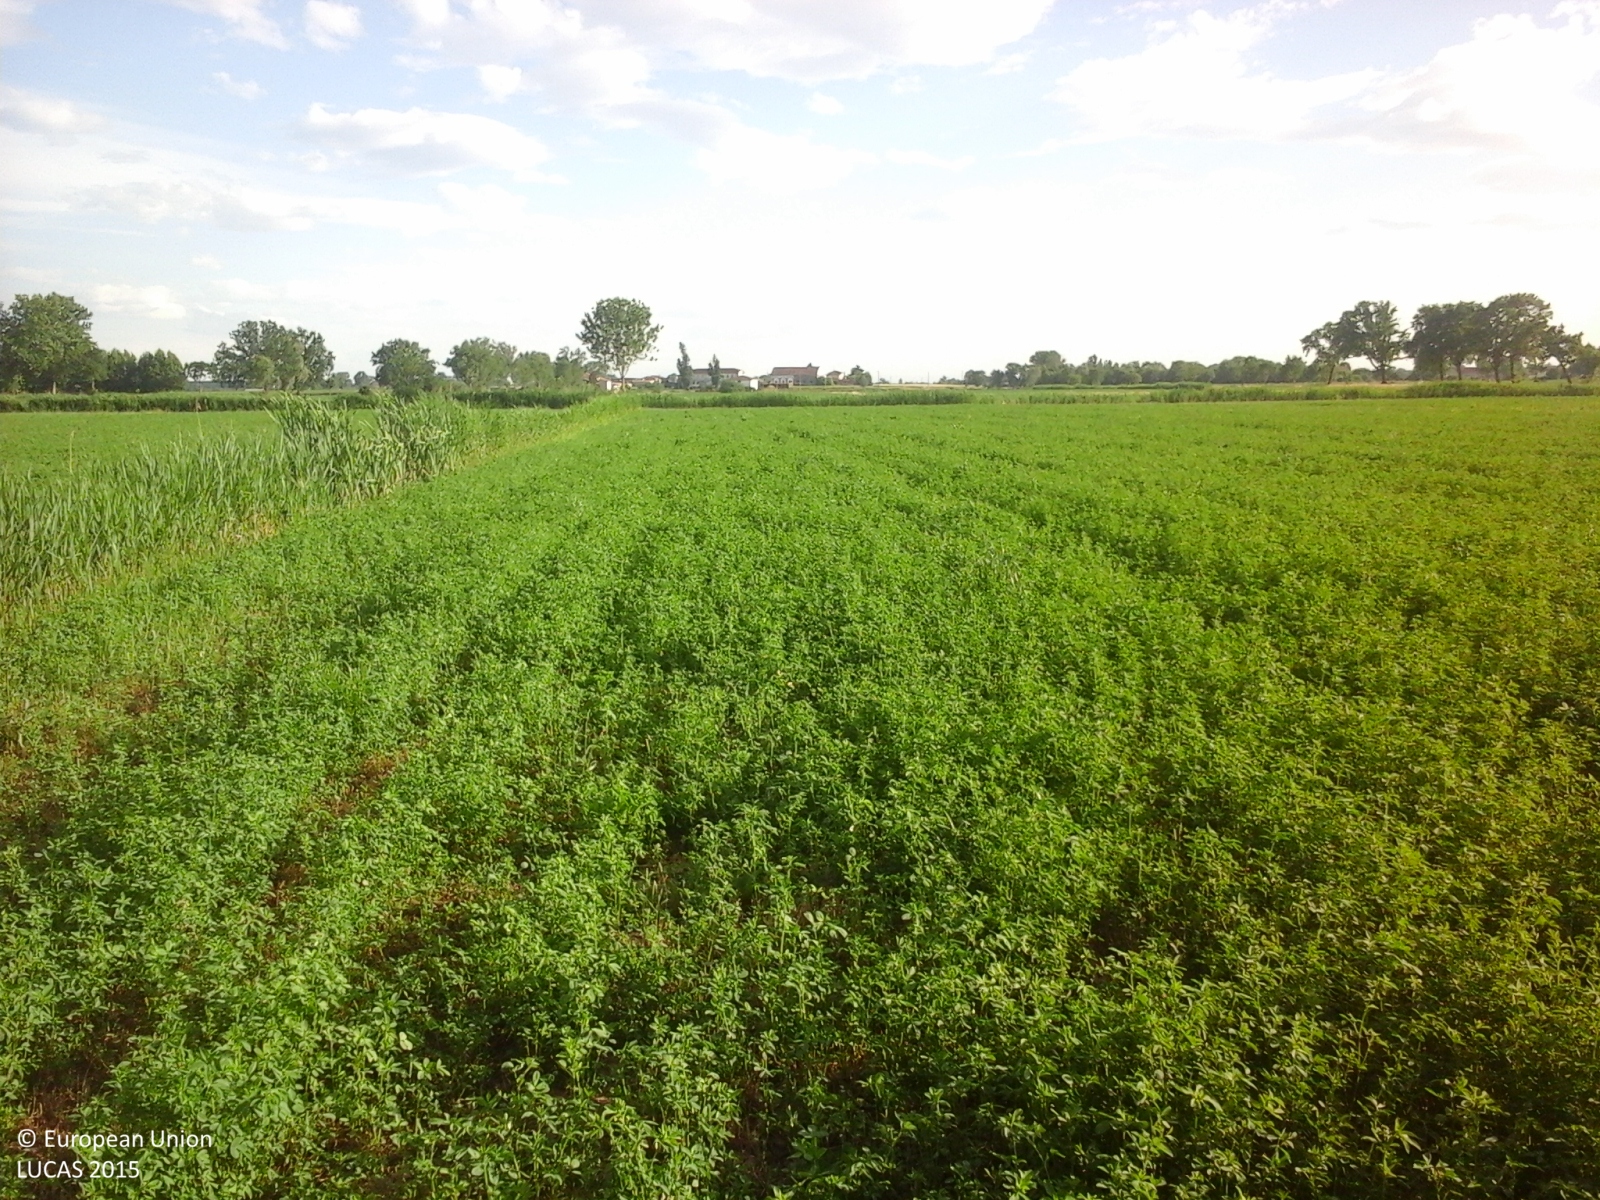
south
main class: Cropland
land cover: Lucerne
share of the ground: > 75 %
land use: Agriculture (excluding fallow land and kitchen gardens)
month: May
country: IT
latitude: 45.1040
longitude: 10.9006
